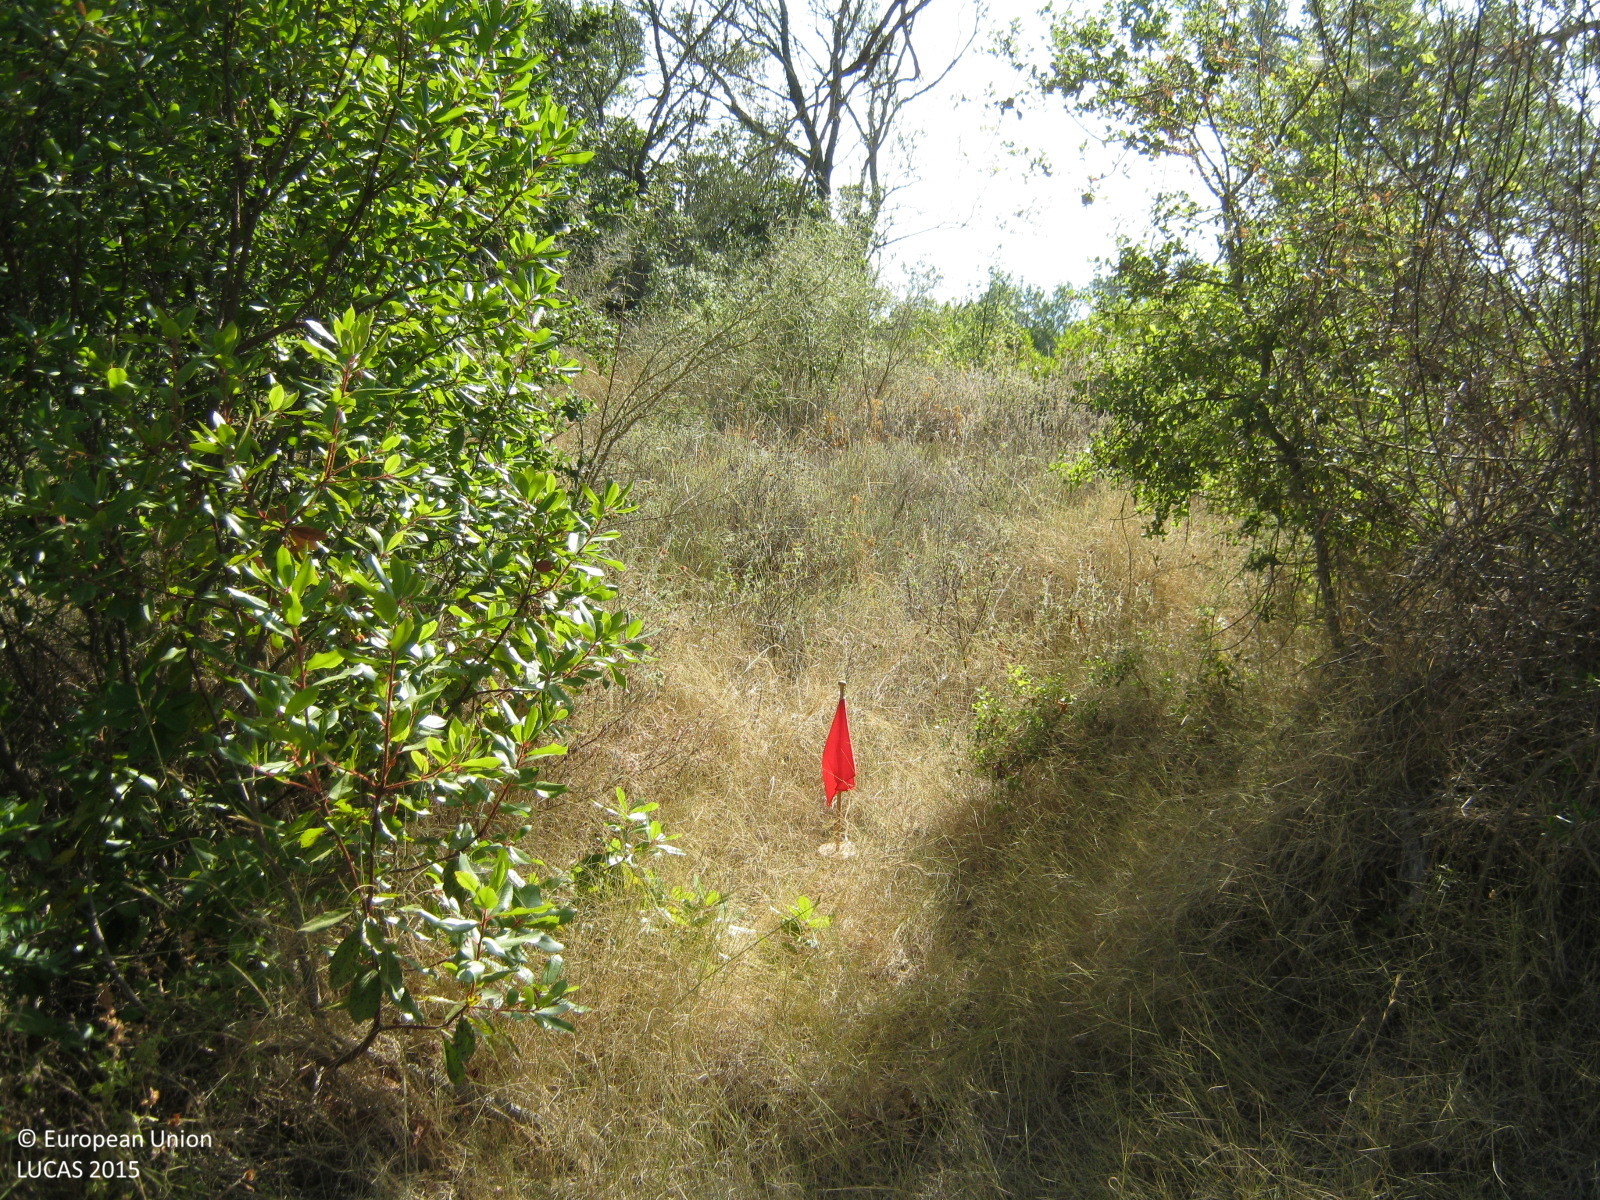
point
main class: Cropland
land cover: Olive groves
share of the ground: 25 - 50 %
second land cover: Shrubland without tree cover
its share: 50 - 75 %
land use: Agriculture (excluding fallow land and kitchen gardens)
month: September
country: GR
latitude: 39.4500
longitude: 19.9542
